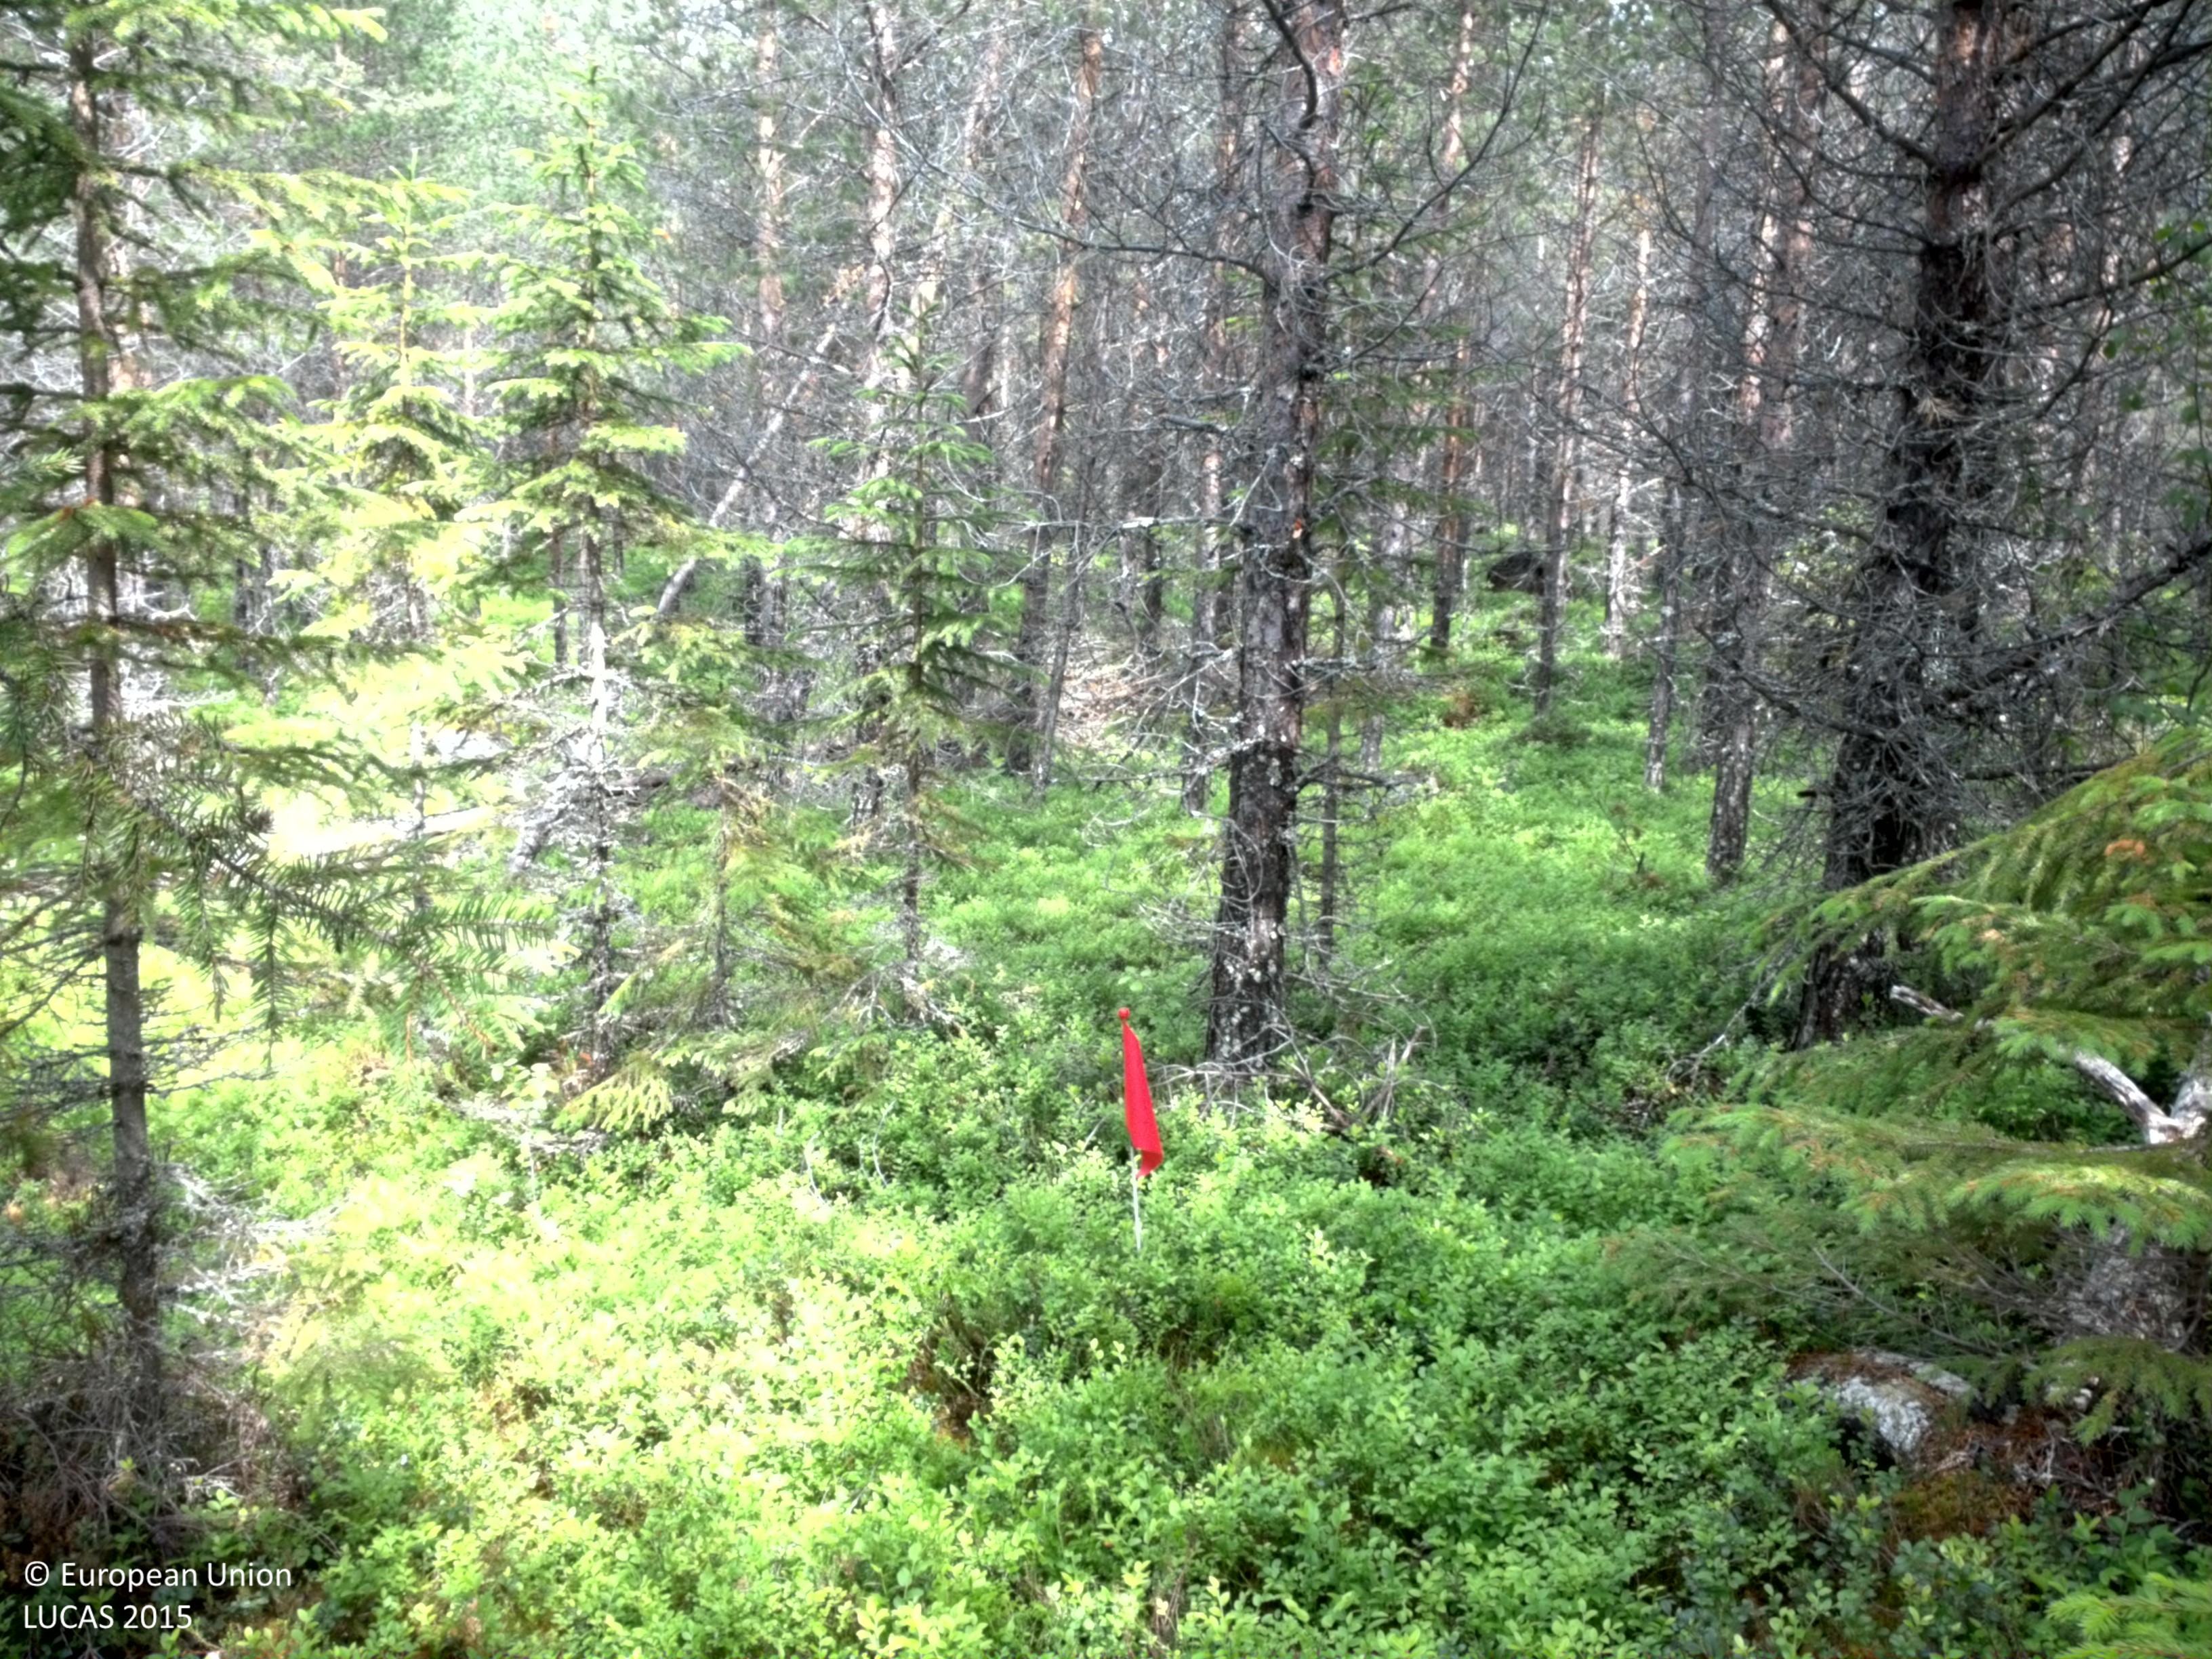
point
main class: Woodland
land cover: Pine dominated coniferous woodland
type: boreal forest
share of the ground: 50 - 75 %
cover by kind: coniferous forest trees 75 %, shrubs 25 %
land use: Forestry
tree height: > 5 m
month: July
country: SE
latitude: 64.7282
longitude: 18.2586
